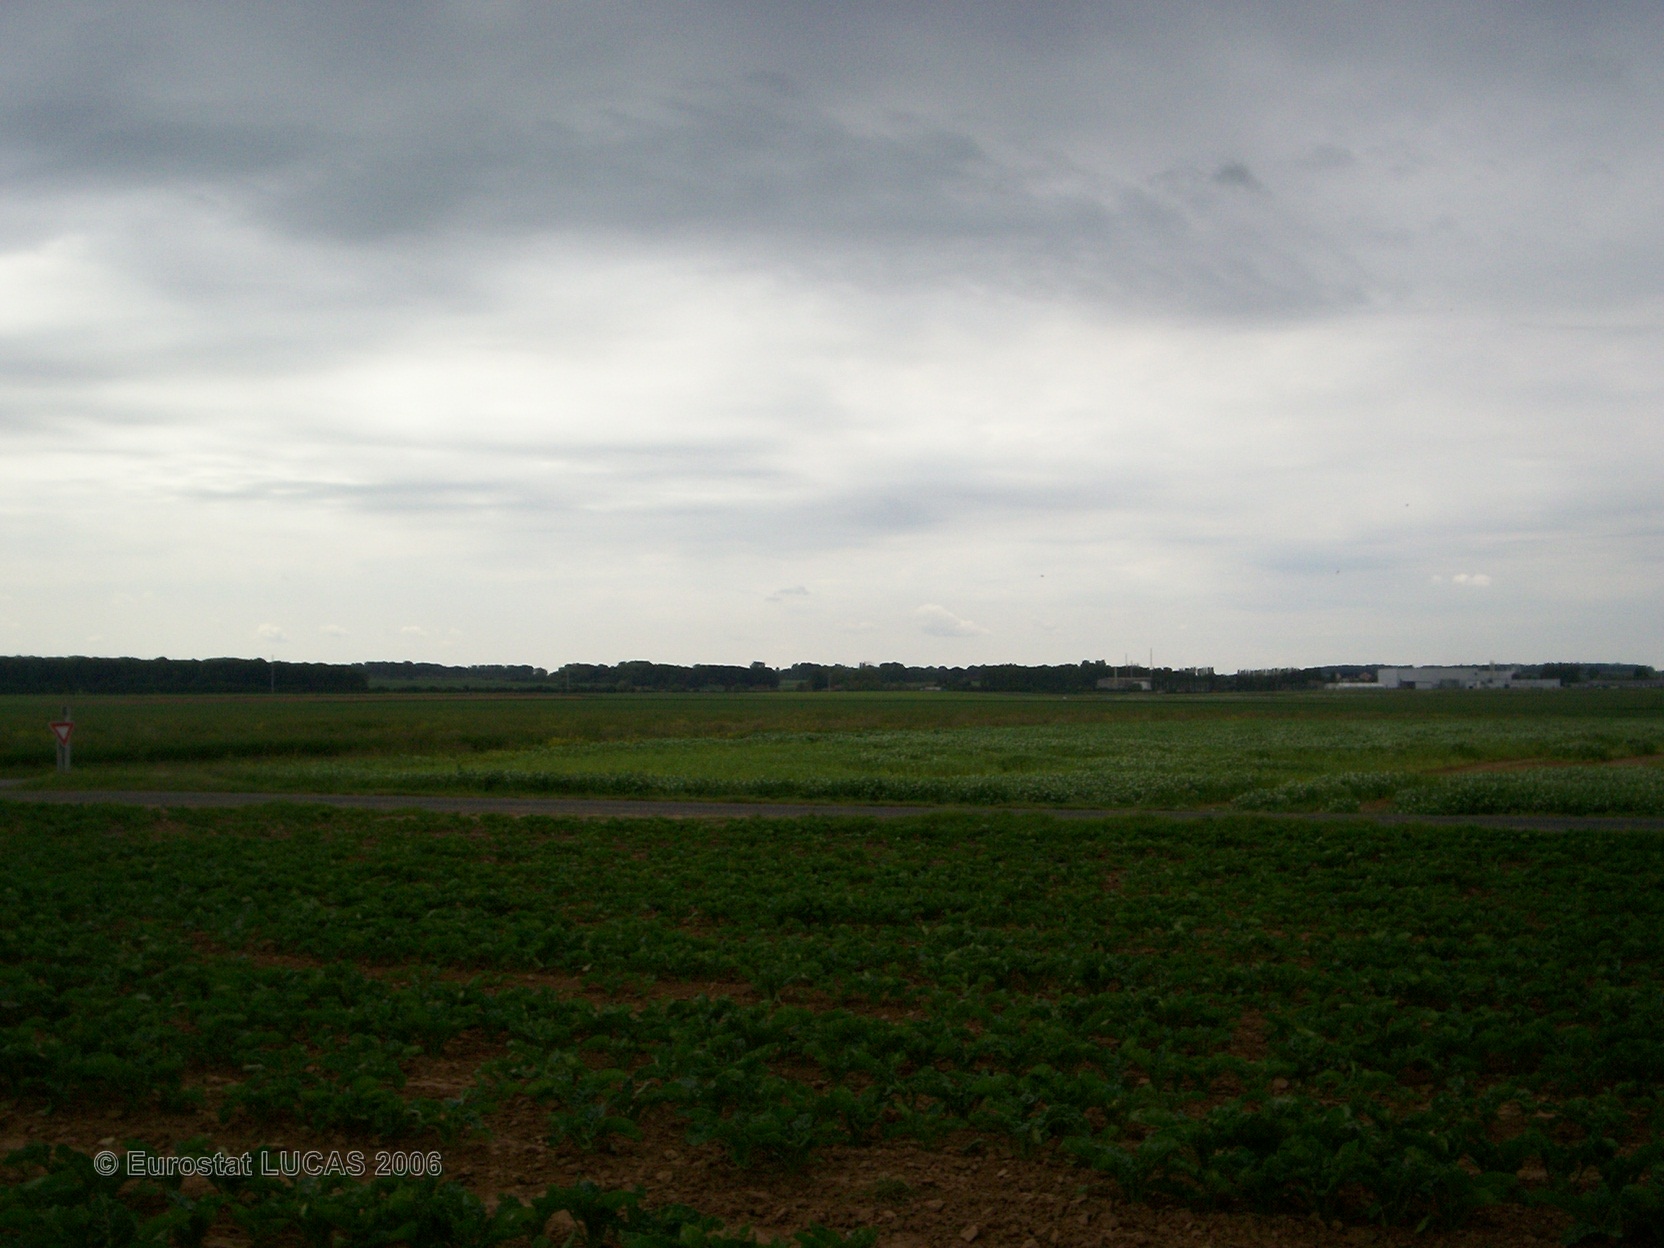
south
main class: Cropland
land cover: Sugar beet
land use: Agriculture (excluding fallow land and kitchen gardens)
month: June
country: FR
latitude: 49.4422
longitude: 2.6655
